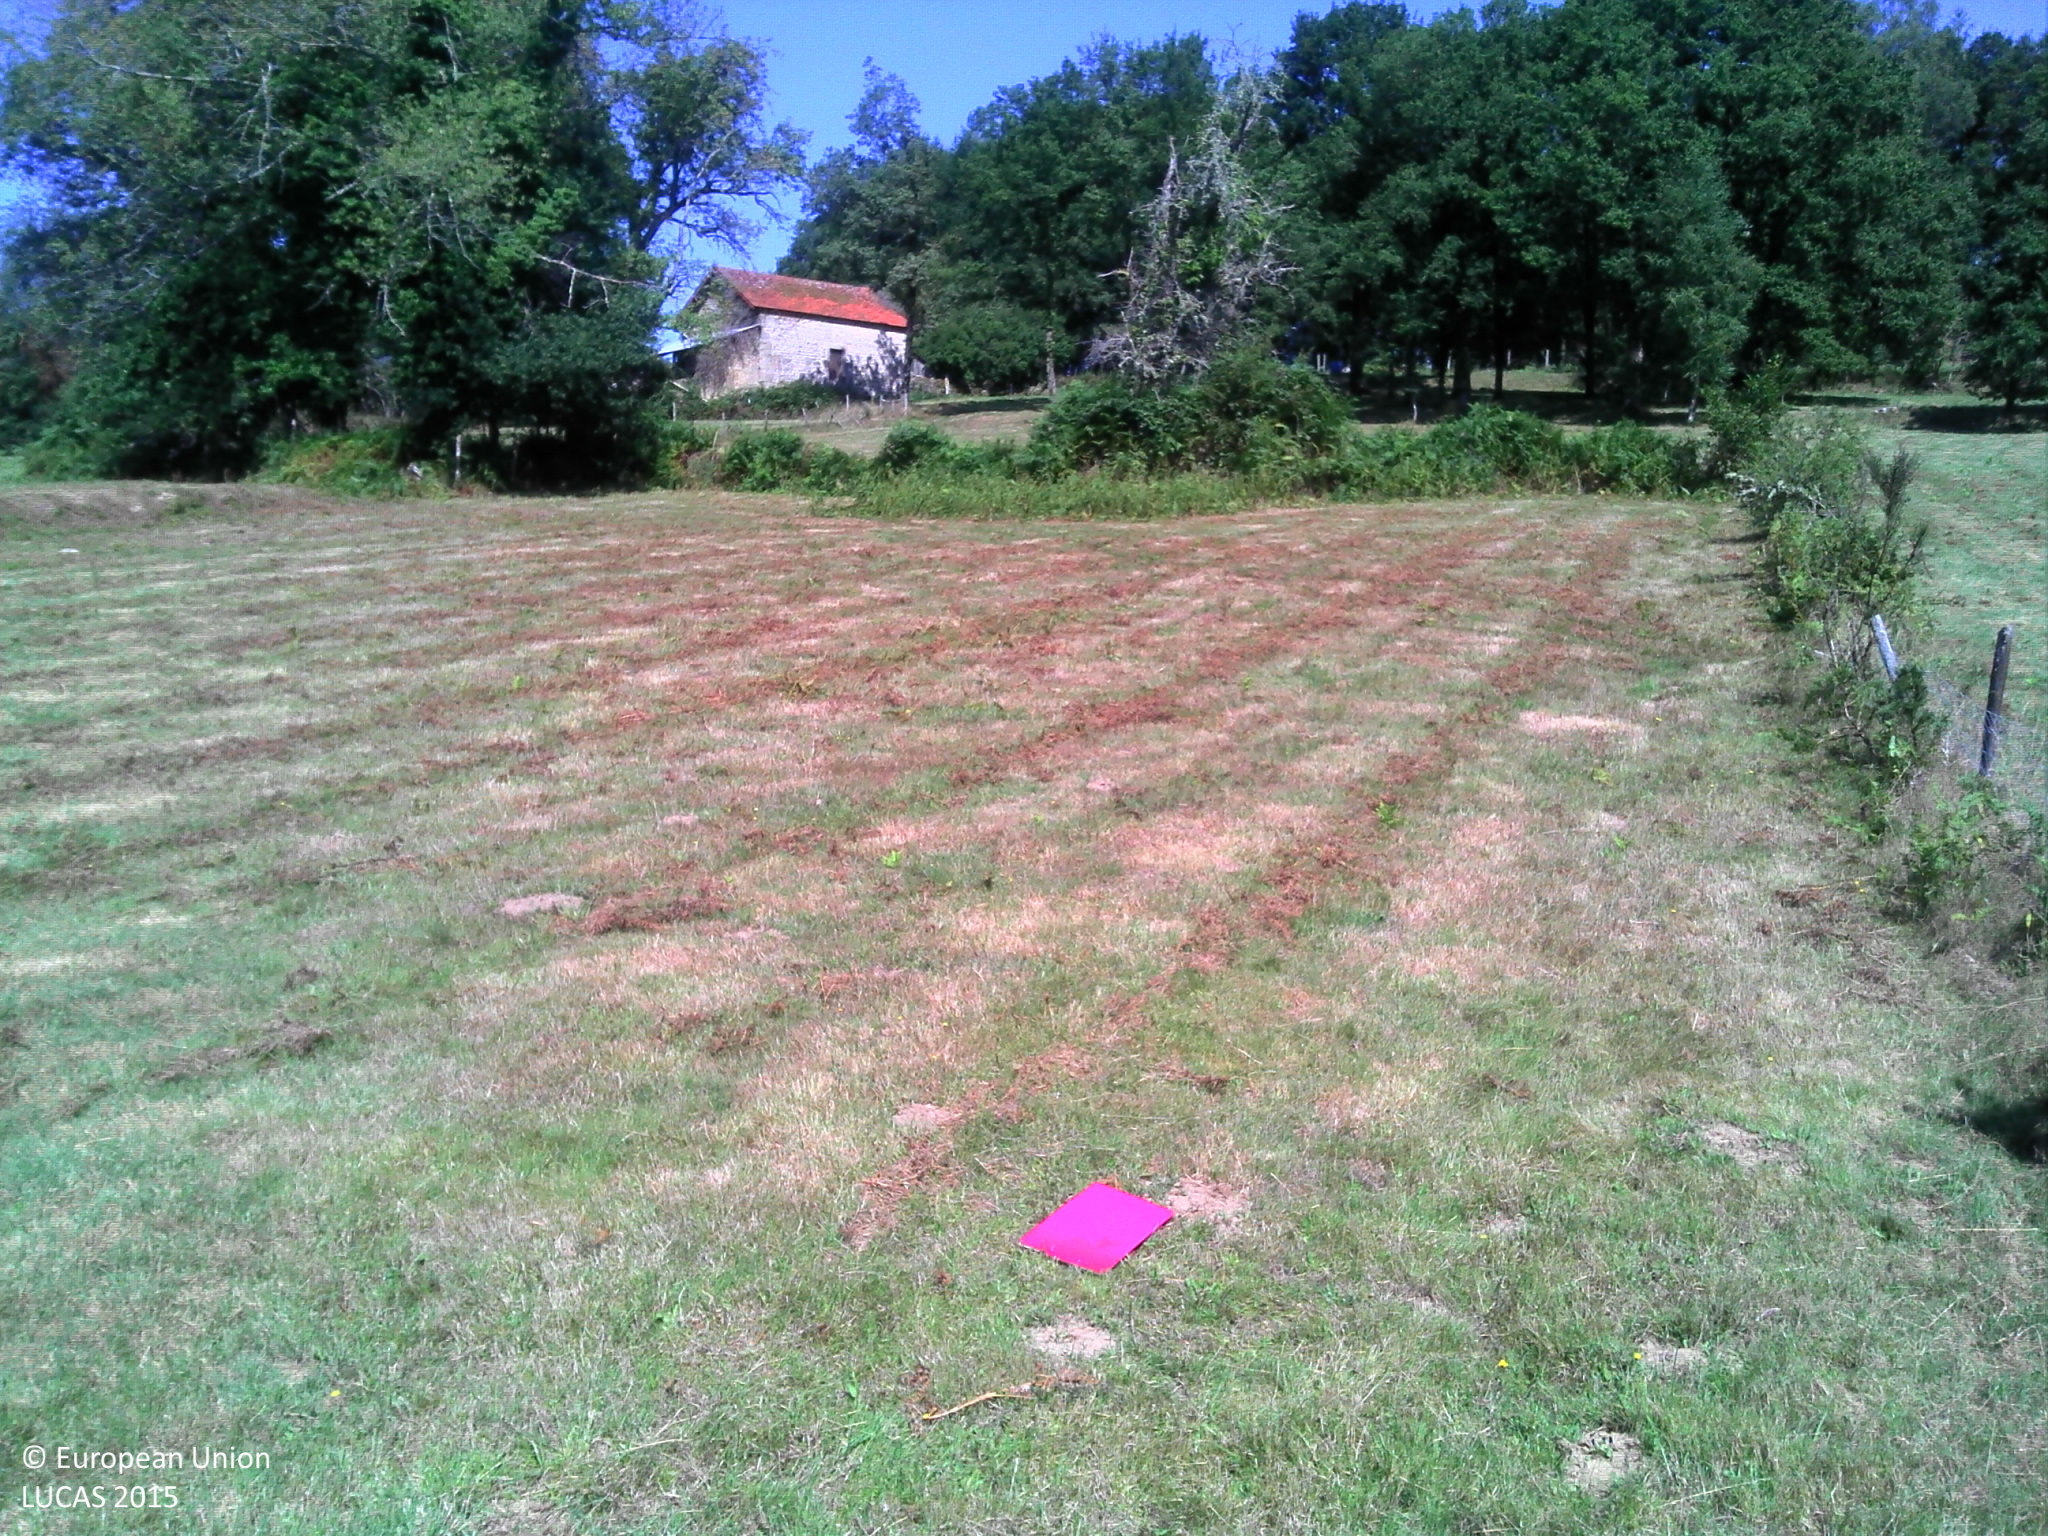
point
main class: Grassland
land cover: Grassland without tree/shrub cover
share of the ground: > 75 %
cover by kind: herbaceous plants 100 %
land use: Agriculture (excluding fallow land and kitchen gardens)
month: August
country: FR
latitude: 45.8204
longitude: 1.8211
